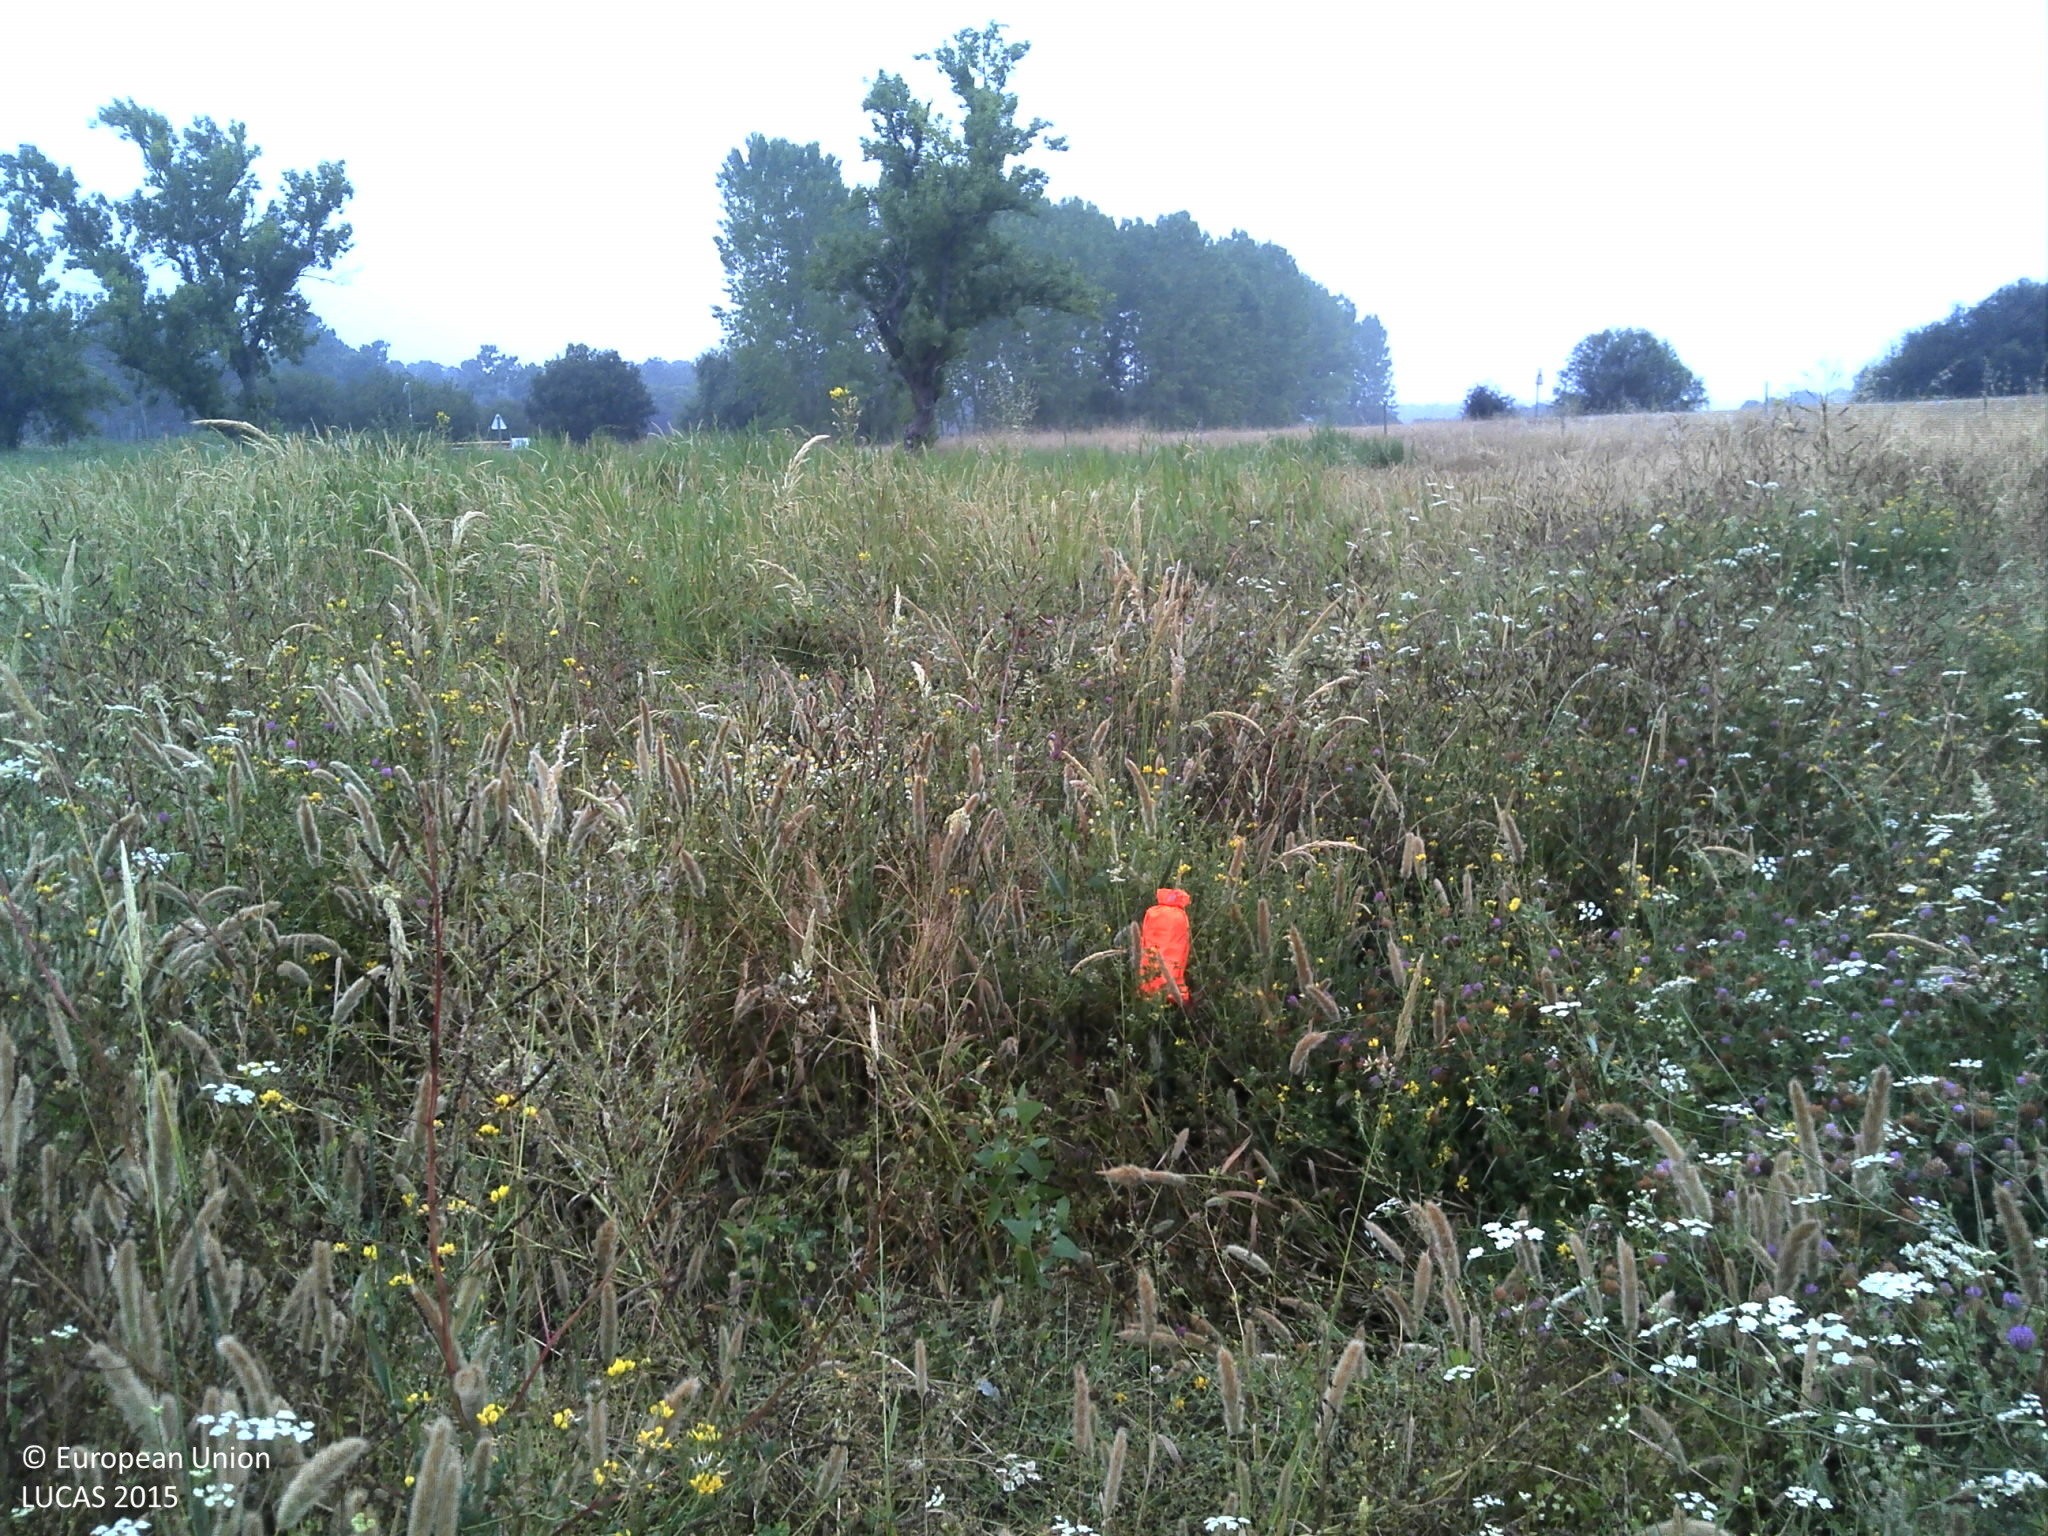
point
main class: Grassland
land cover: Spontaneously vegetated surfaces
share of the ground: > 75 %
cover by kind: herbaceous plants 95 %, unconsolidated bare surface 5 %
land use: Fallow land
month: June
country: PT
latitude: 38.5327
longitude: -9.1252
